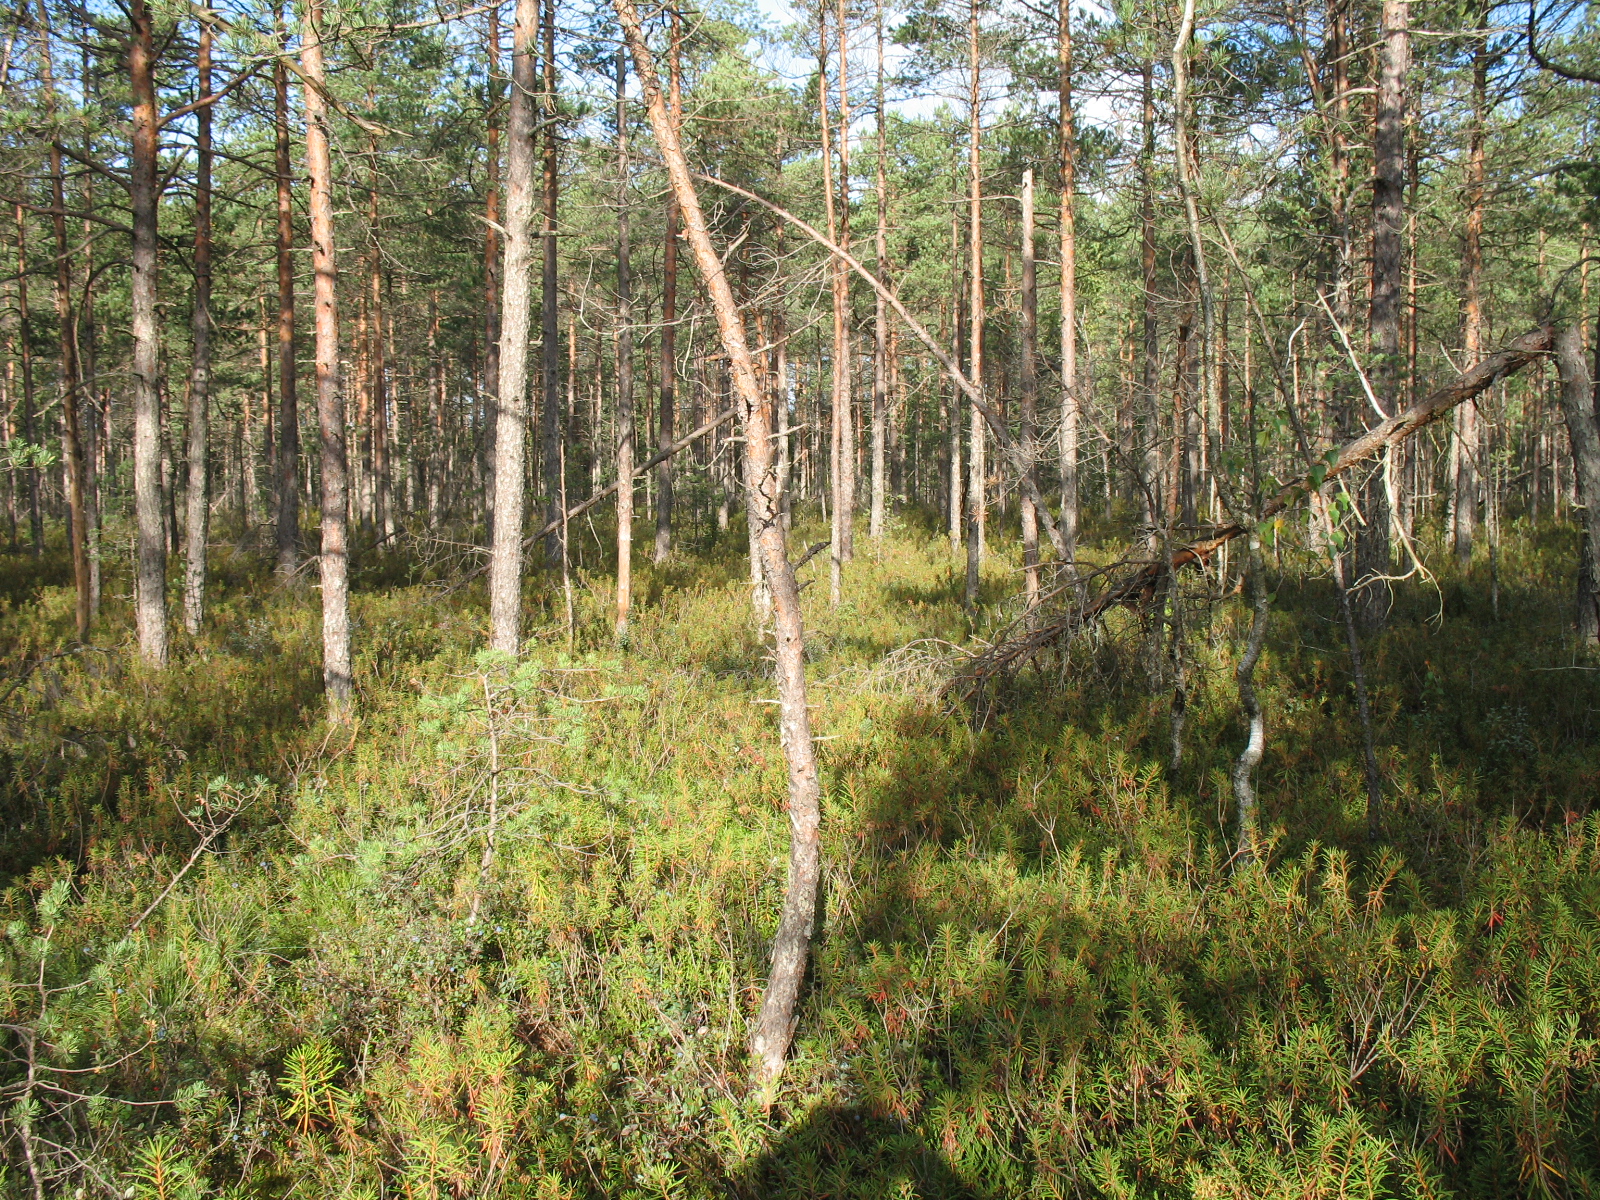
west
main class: Woodland
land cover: Pine dominated coniferous woodland
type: hemiboreal forest and nemoral coniferous forest and mixed broadleaved-coniferous forest
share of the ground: 25 - 50 %
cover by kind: coniferous forest trees 40 %, herbaceous plants 30 %, lichens and mosses 30 %
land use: Forestry
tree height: > 5 m
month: August
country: LV
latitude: 56.2619
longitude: 25.9713
